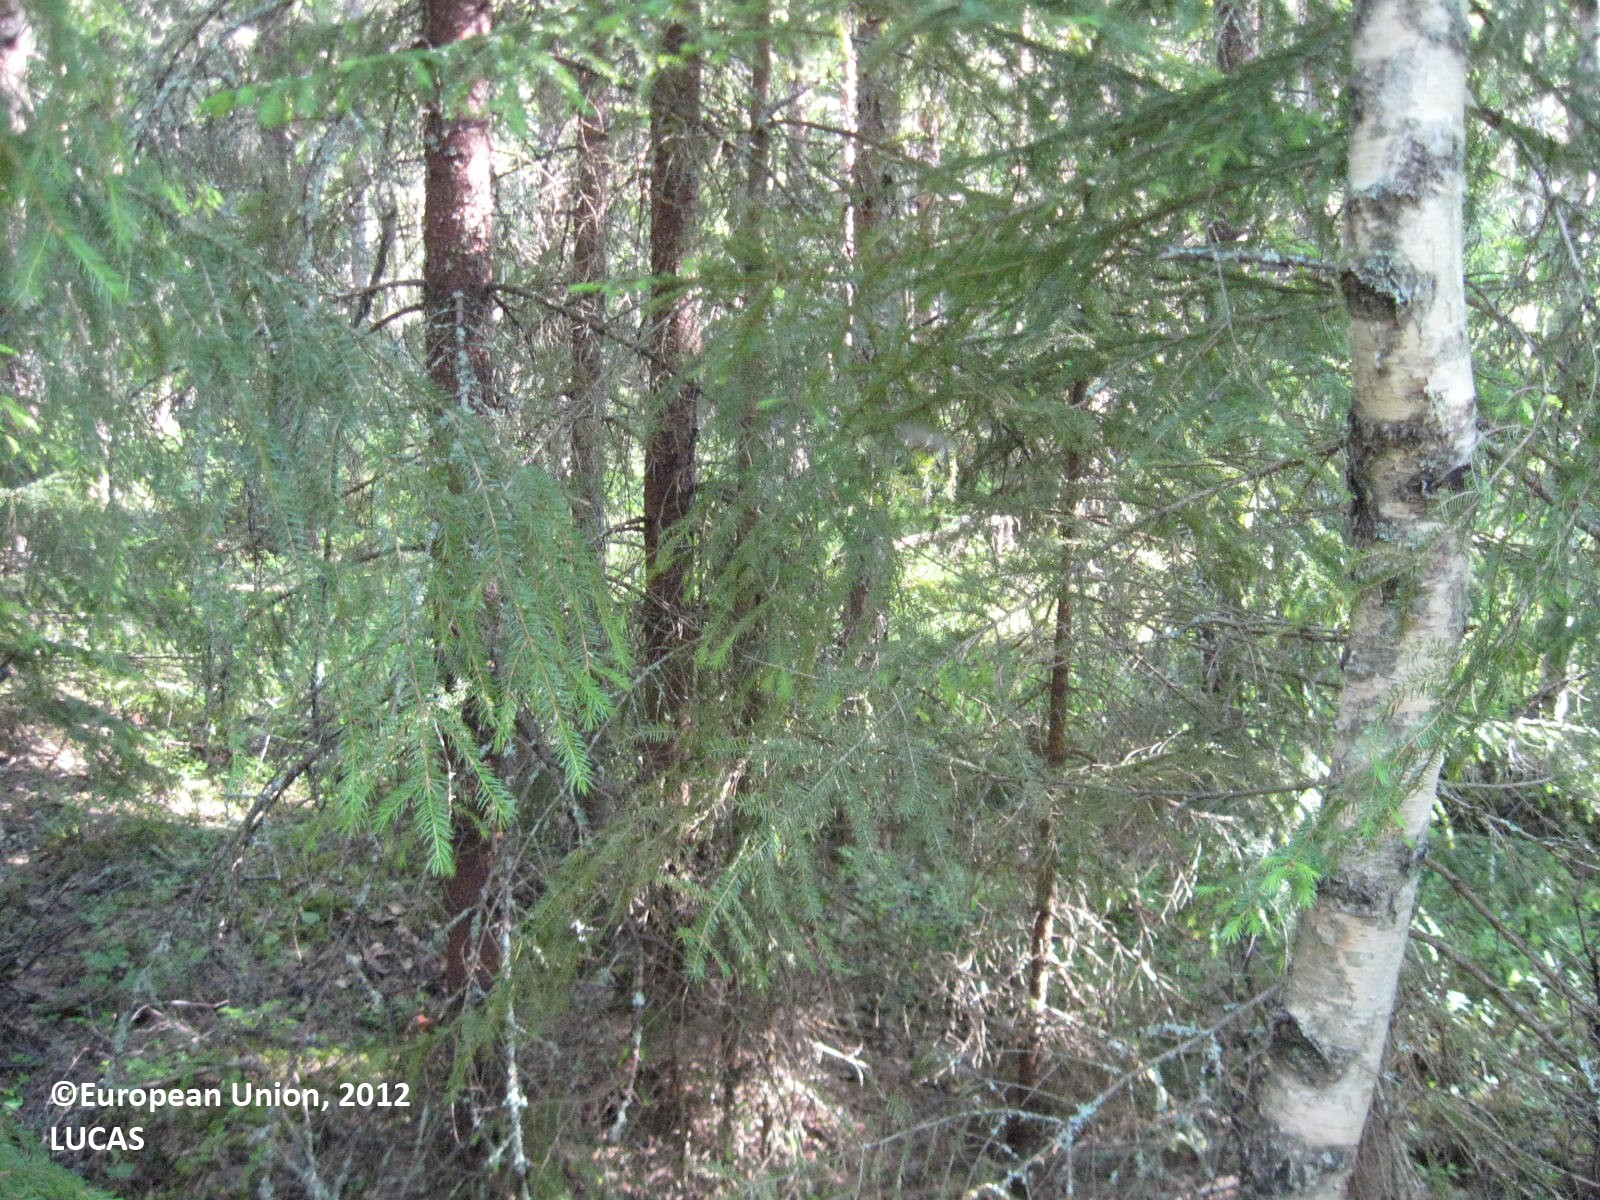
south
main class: Woodland
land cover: Spruce dominated mixed woodland
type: boreal forest
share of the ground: > 75 %
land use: Forestry
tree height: > 5 m
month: June
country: FI
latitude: 62.7490
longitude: 21.5724
